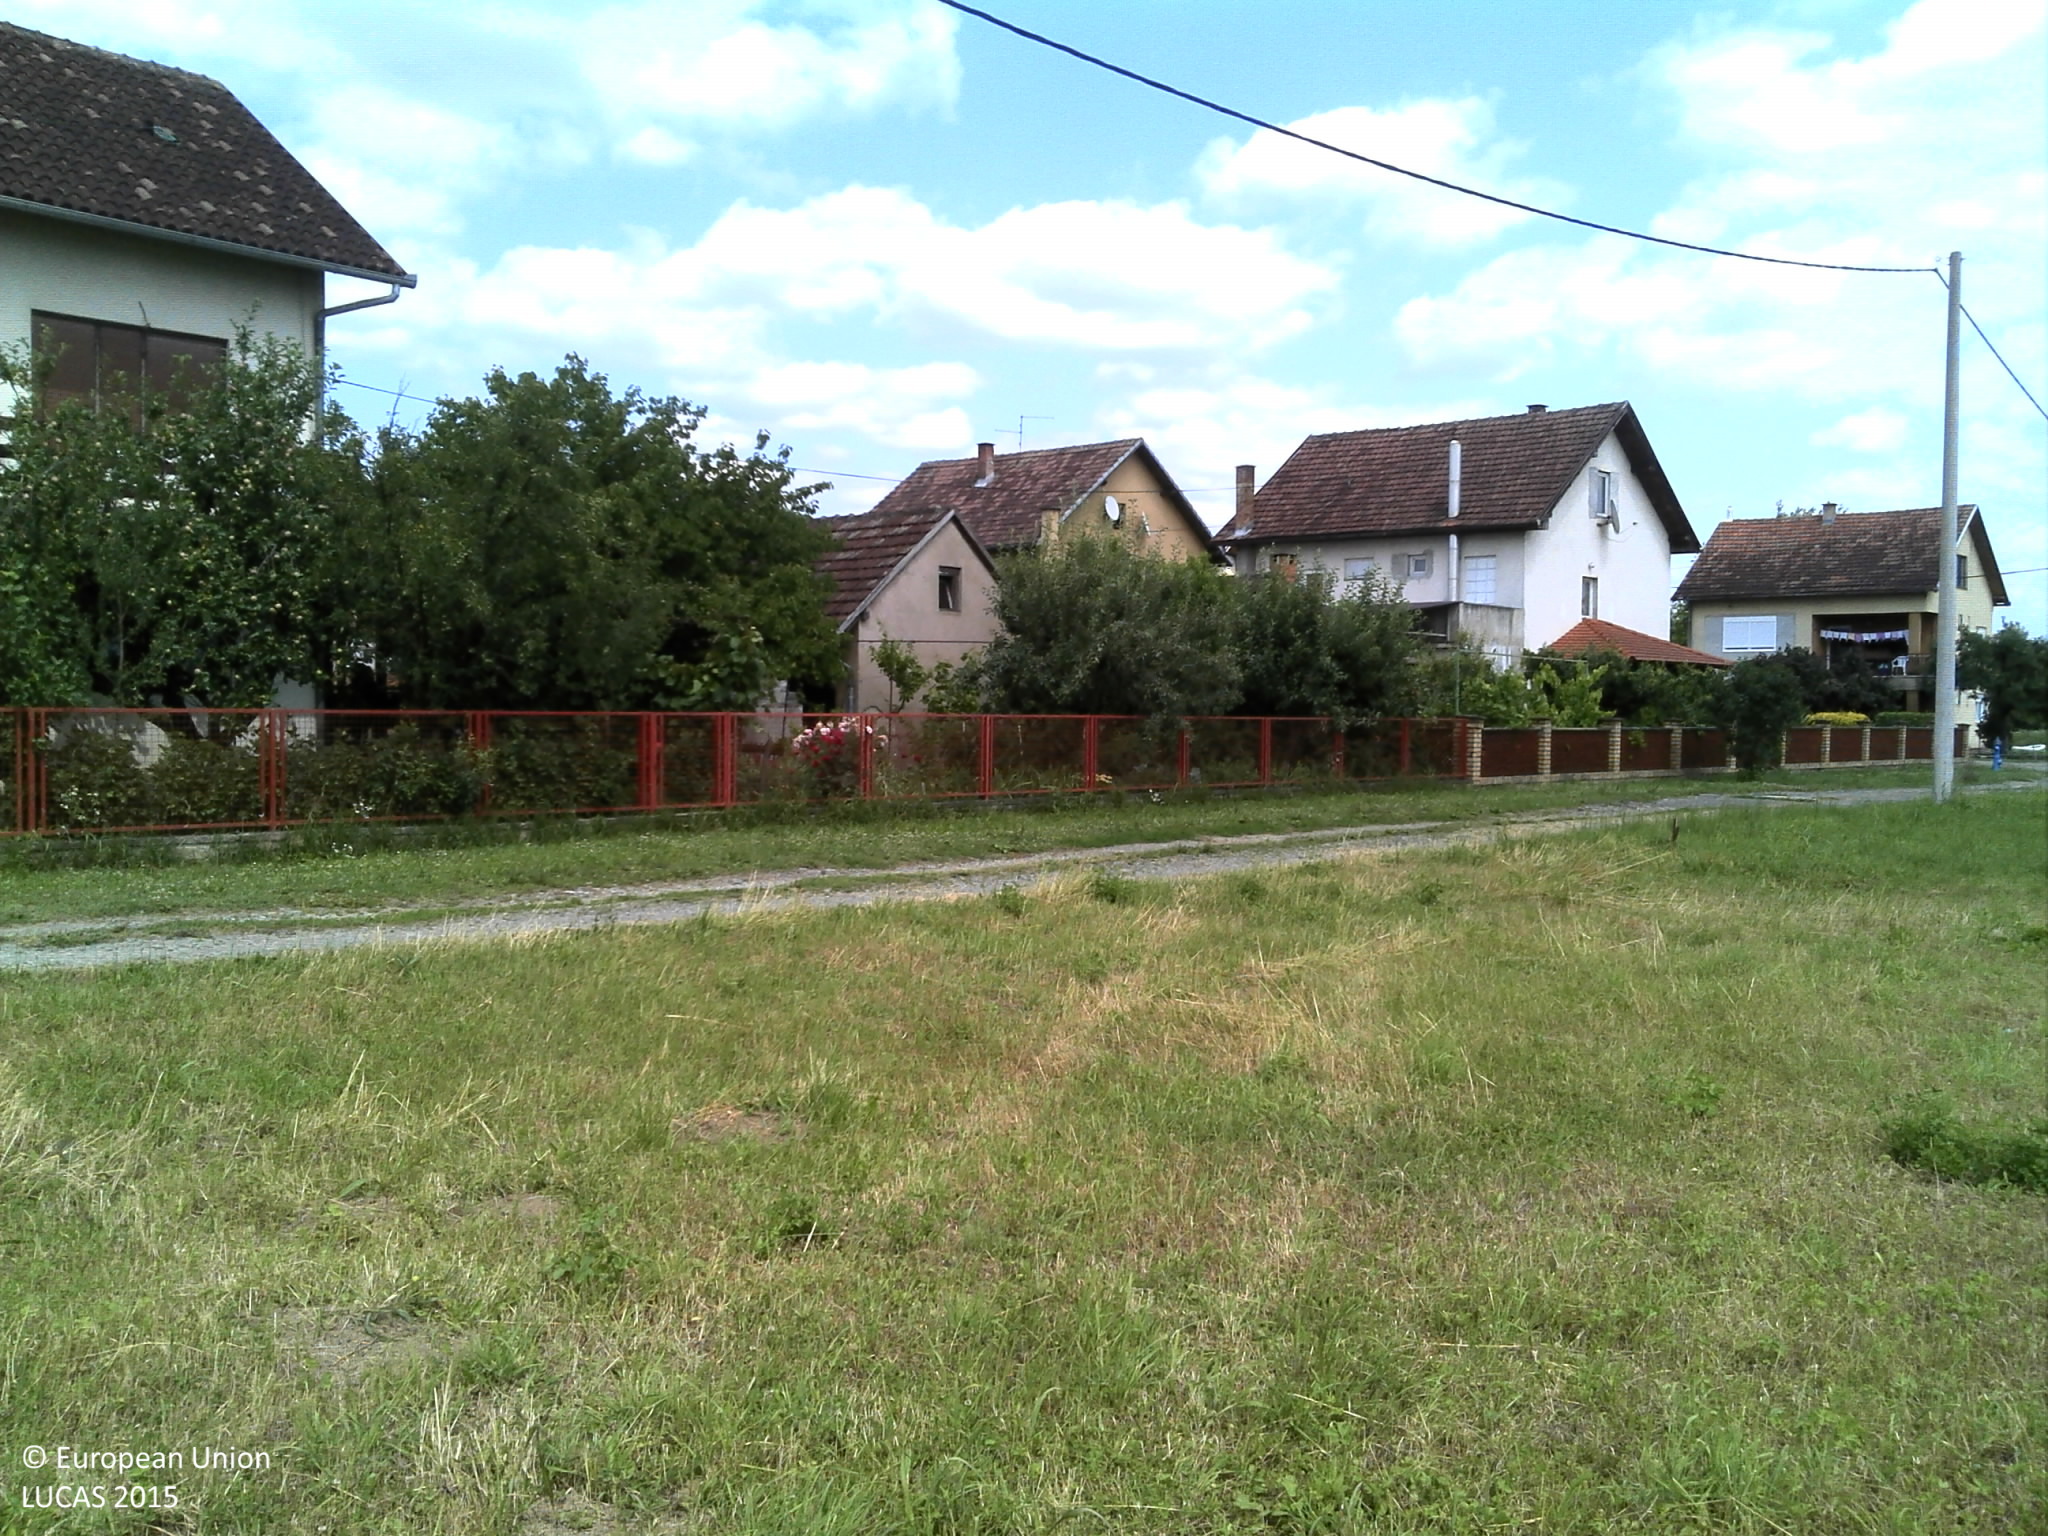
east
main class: Grassland
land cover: Grassland without tree/shrub cover
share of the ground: > 75 %
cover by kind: herbaceous plants 100 %
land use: Agriculture (excluding fallow land and kitchen gardens)
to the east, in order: Grassland without tree/shrub cover; Artificial constructions in urban areas
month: June
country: HR
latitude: 45.2585
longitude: 17.1994
